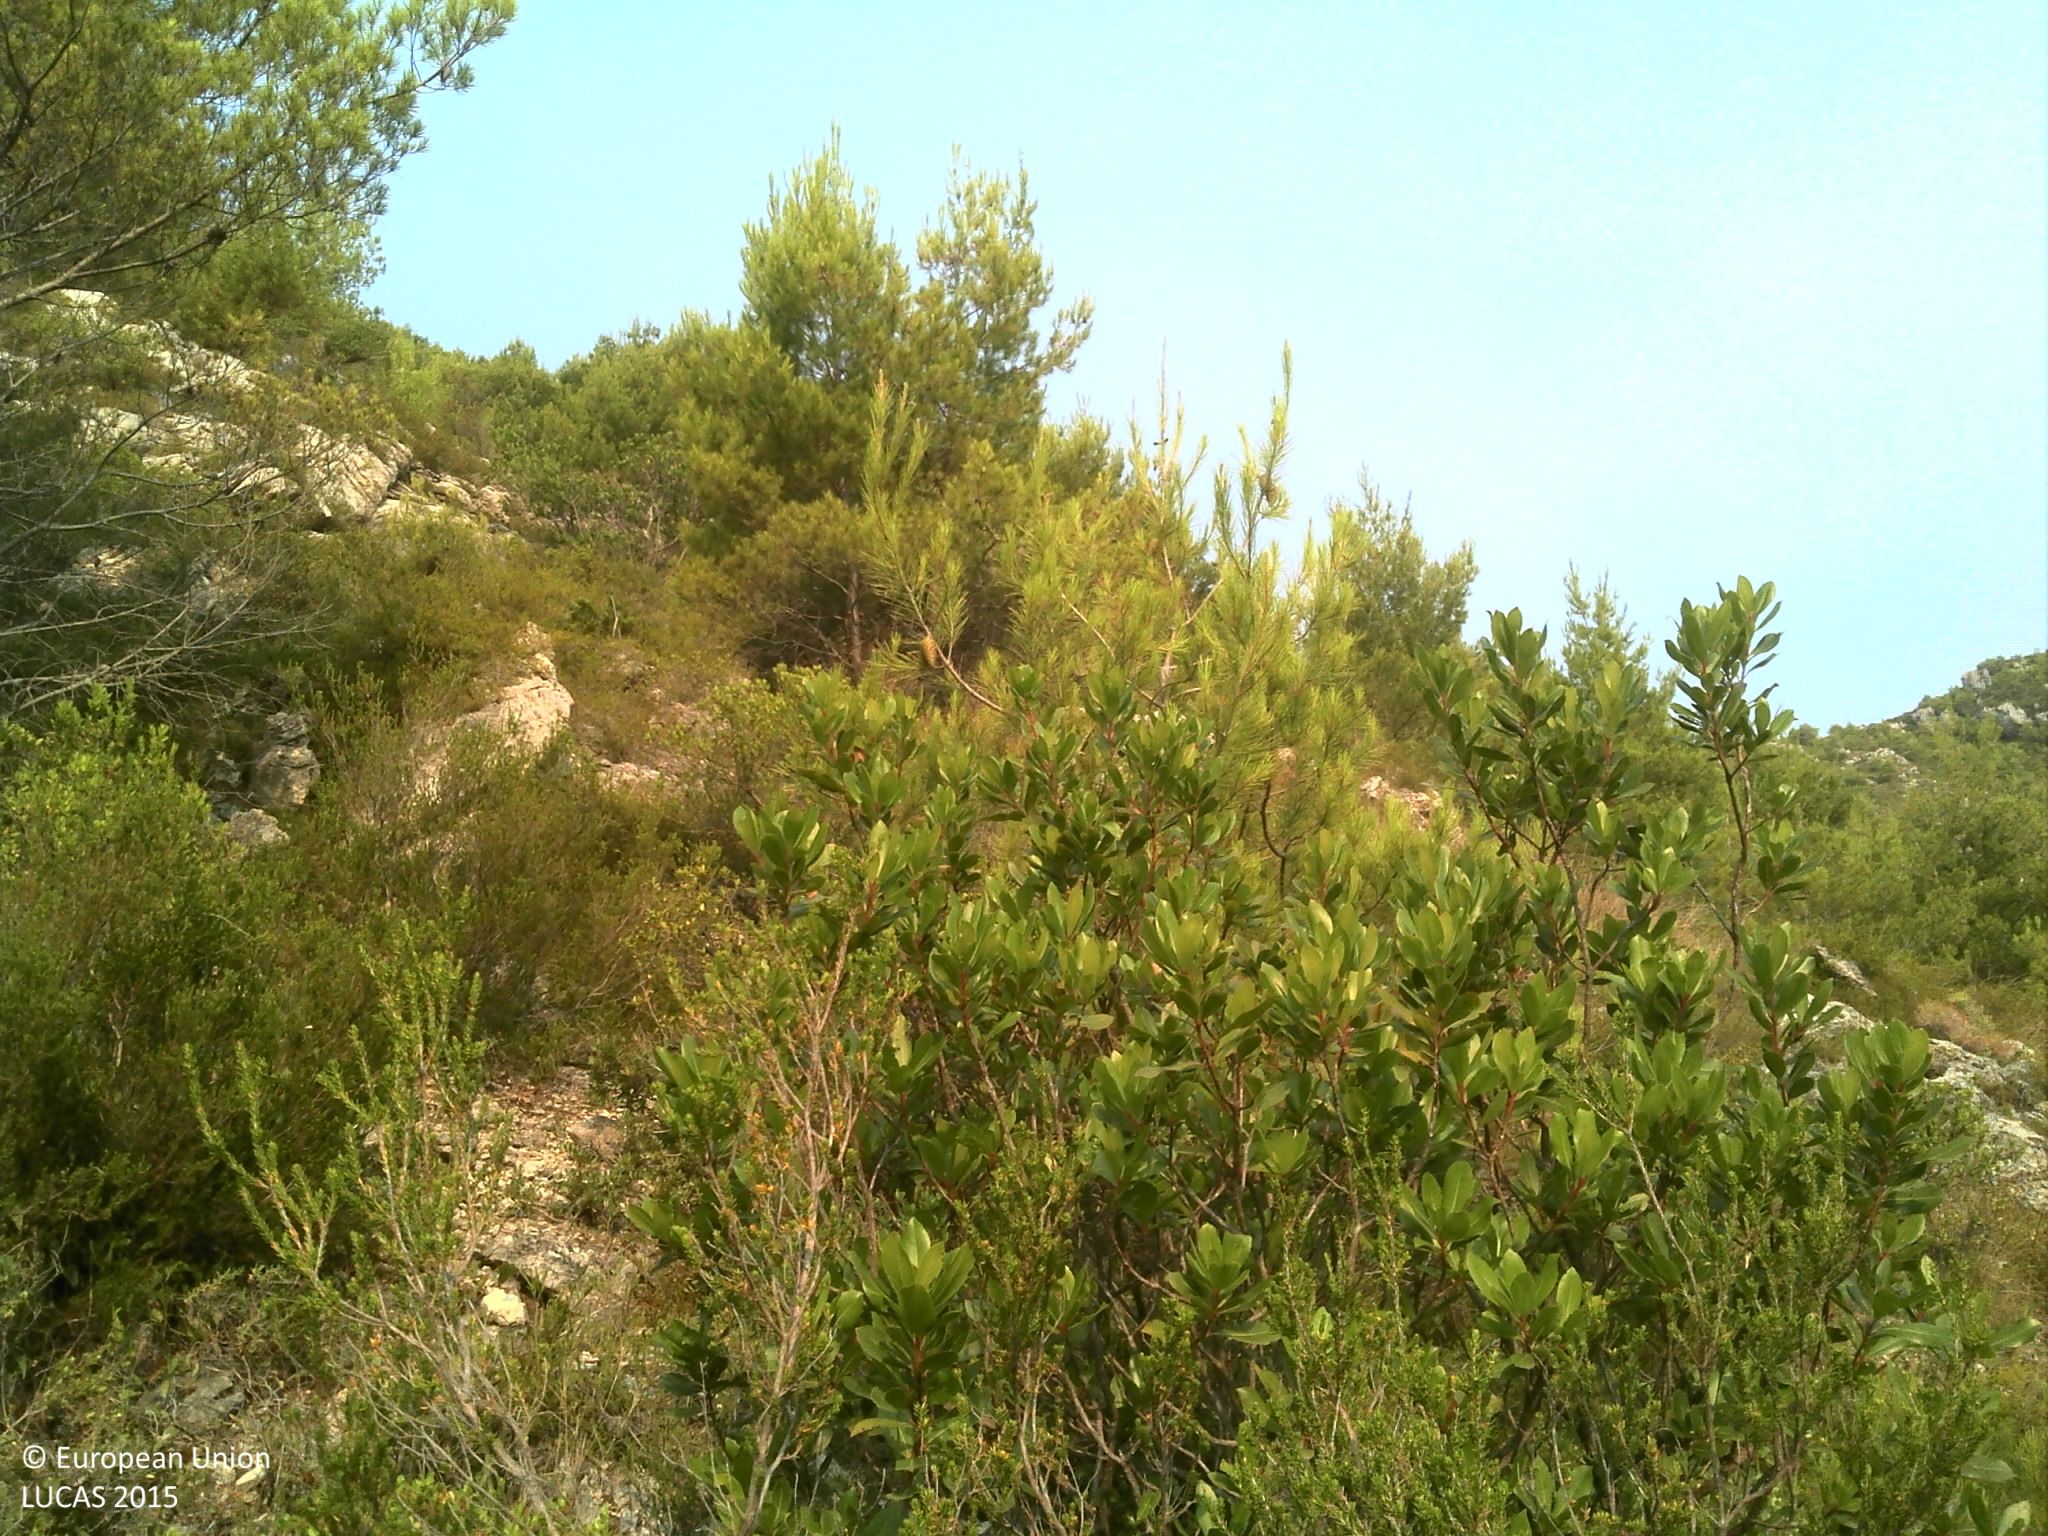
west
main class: Woodland
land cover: Pine dominated coniferous woodland
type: coniferous forest of the mediterranean region
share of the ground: > 75 %
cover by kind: coniferous forest trees 60 %, shrubs 20 %, consolidated bare surface 10 %, unconsolidated bare surface 10 %
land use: Semi-natural and natural areas not in use
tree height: > 5 m
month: July
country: HR
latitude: 42.8134
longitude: 17.7070
